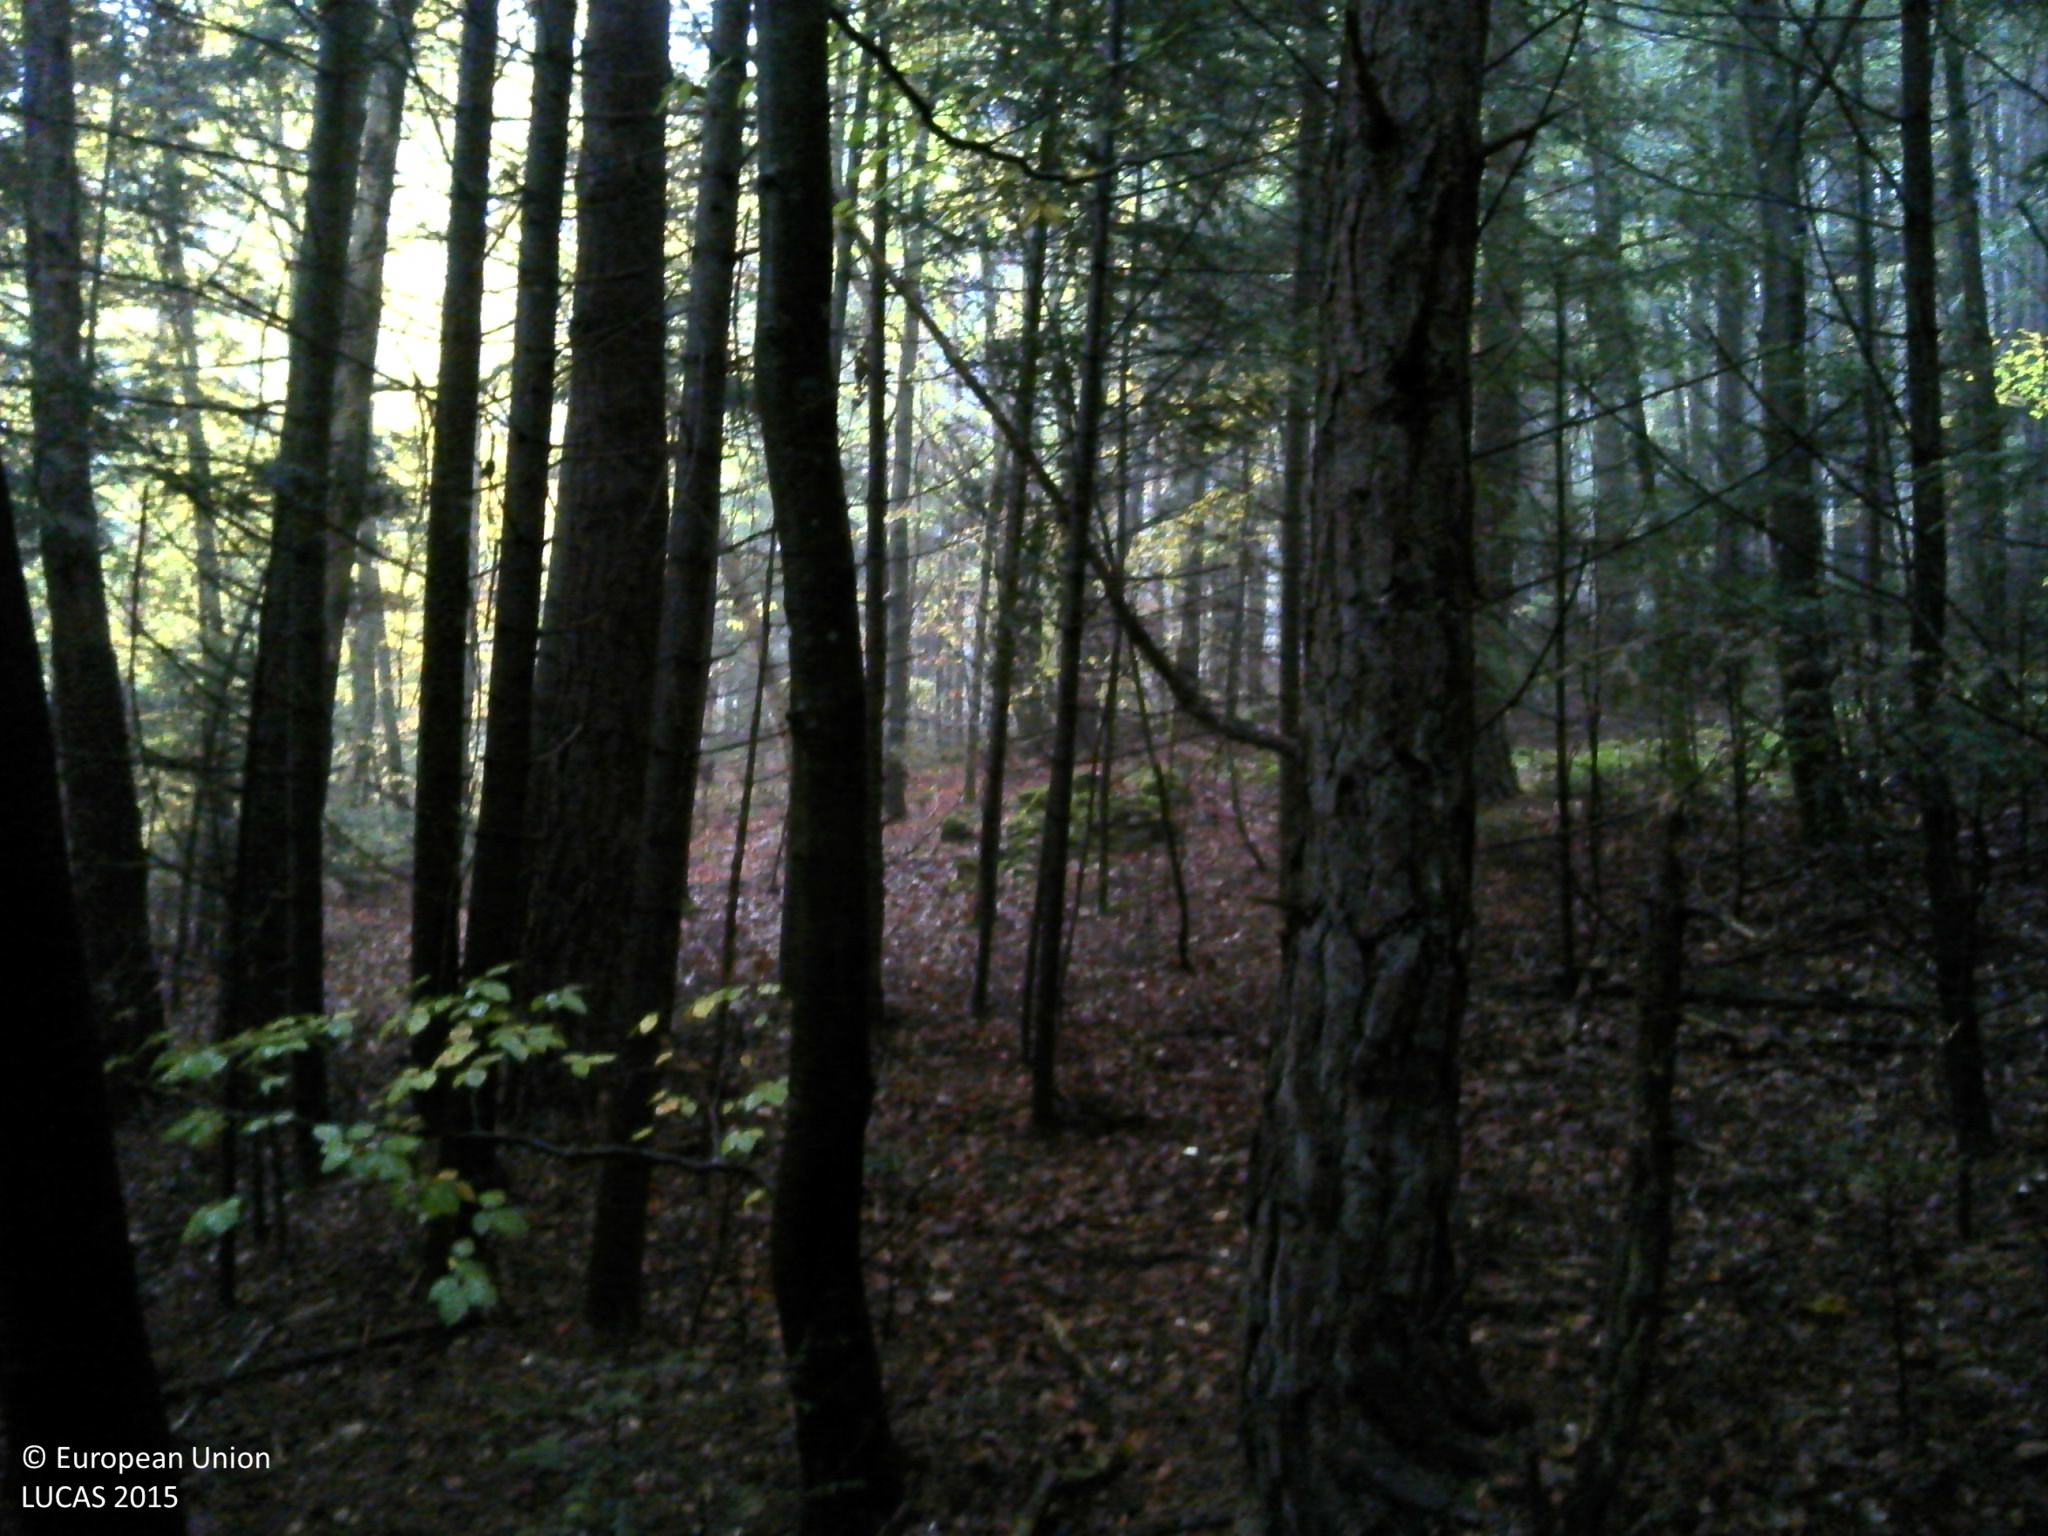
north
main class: Woodland
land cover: Pine dominated mixed woodland
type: mountainous beech forest
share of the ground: > 75 %
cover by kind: coniferous forest trees 50 %, broadleaved forest trees 40 %, unconsolidated bare surface 10 %
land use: Forestry
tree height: > 5 m
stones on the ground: 10 - 25 %
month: October
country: FR
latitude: 45.3754
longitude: 3.7841
